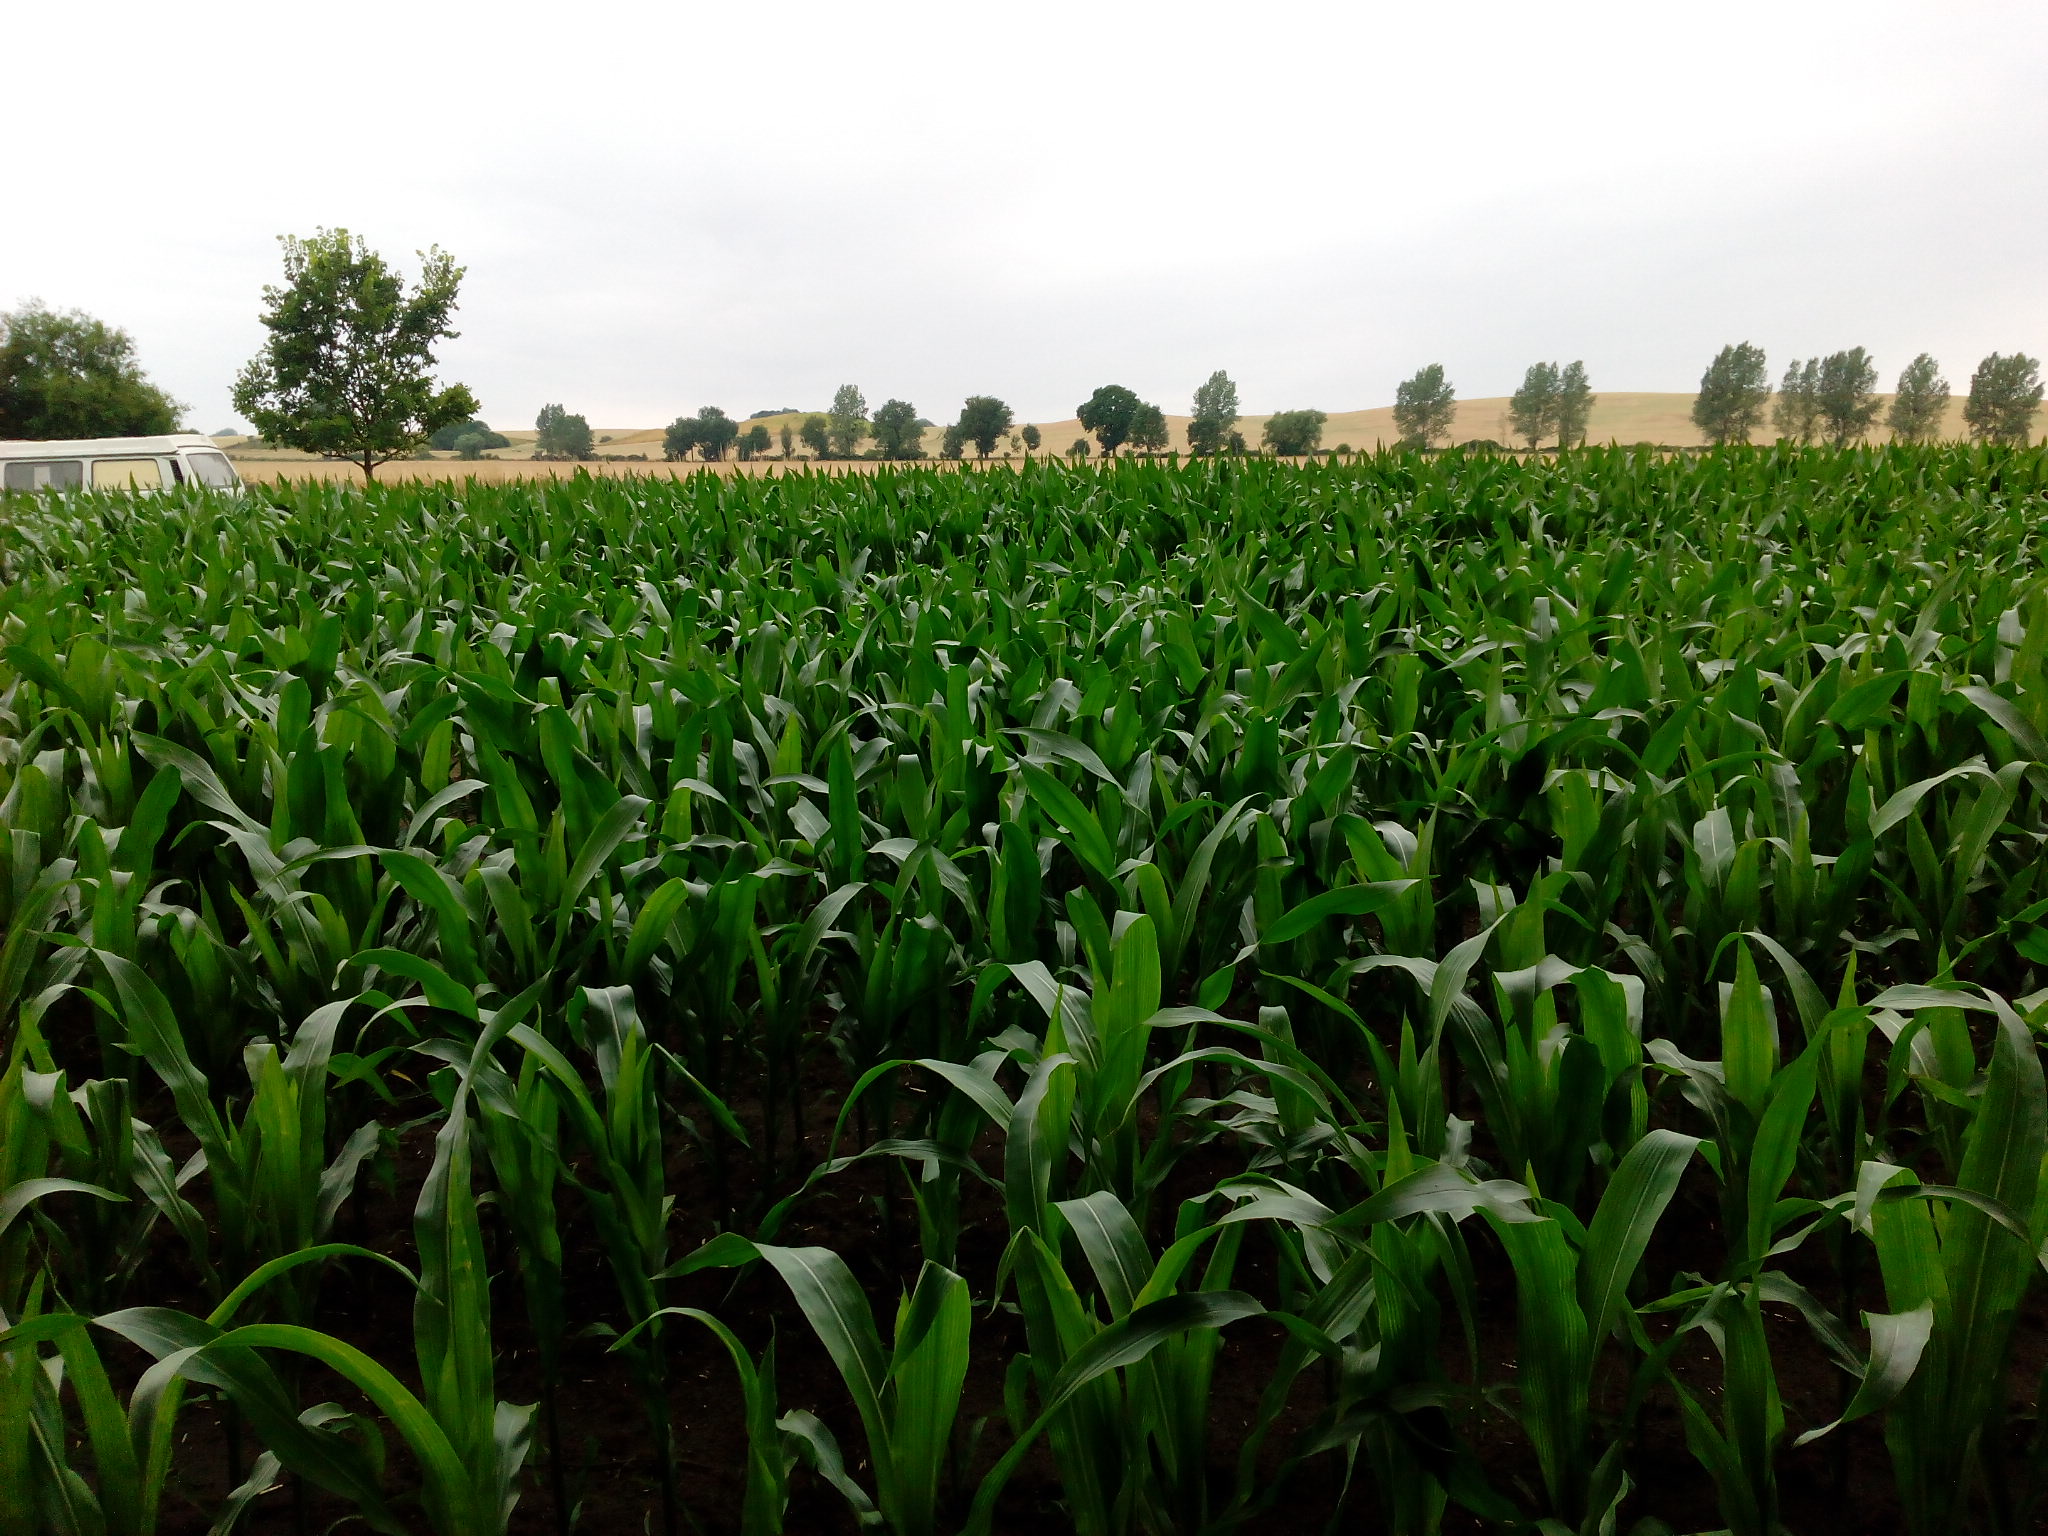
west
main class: Woodland
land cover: Broadleaved woodland
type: mesophytic deciduous forest
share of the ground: > 75 %
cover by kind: broadleaved forest trees 90 %, herbaceous plants 5 %, consolidated bare surface 5 %
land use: Semi-natural and natural areas not in use
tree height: > 5 m
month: July
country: DE
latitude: 53.3474
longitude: 14.1917
